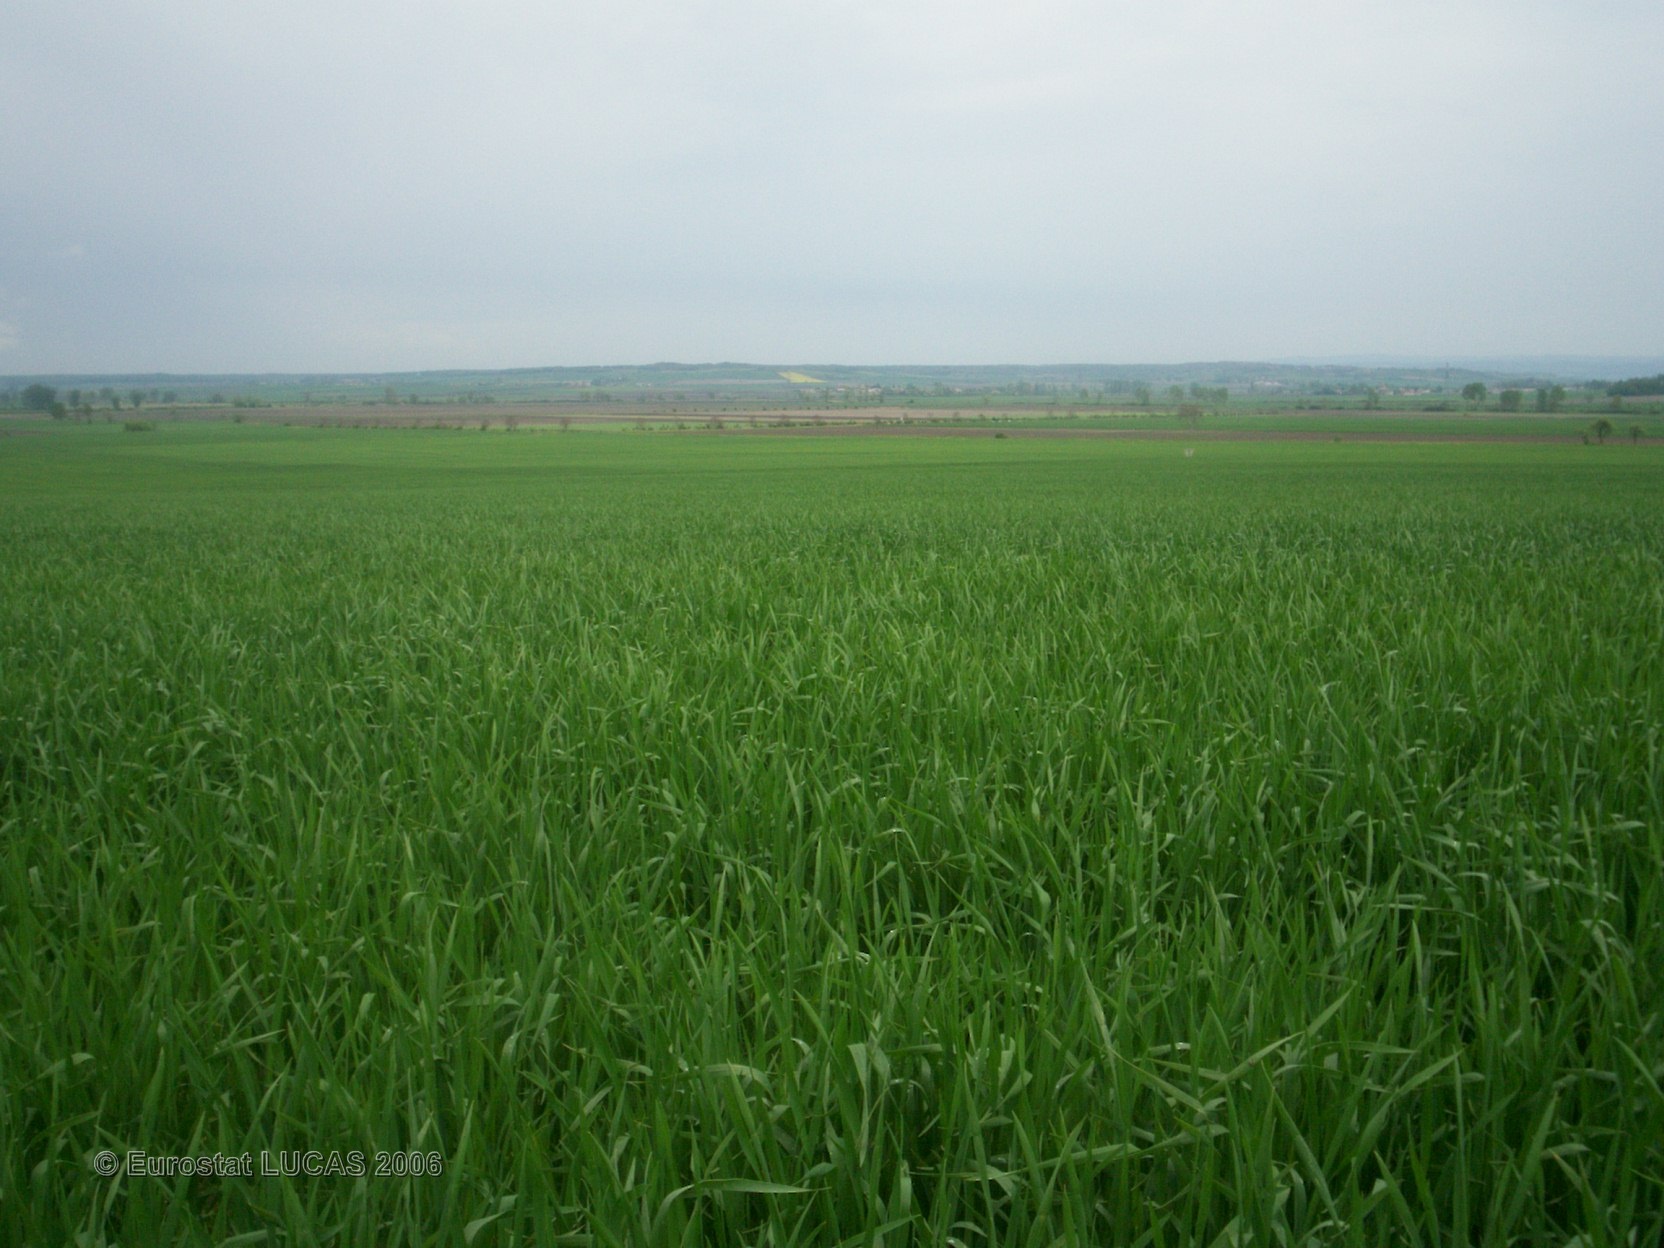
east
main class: Cropland
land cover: Common wheat
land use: Agriculture (excluding fallow land and kitchen gardens)
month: May
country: FR
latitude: 45.9931
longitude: 3.2472
